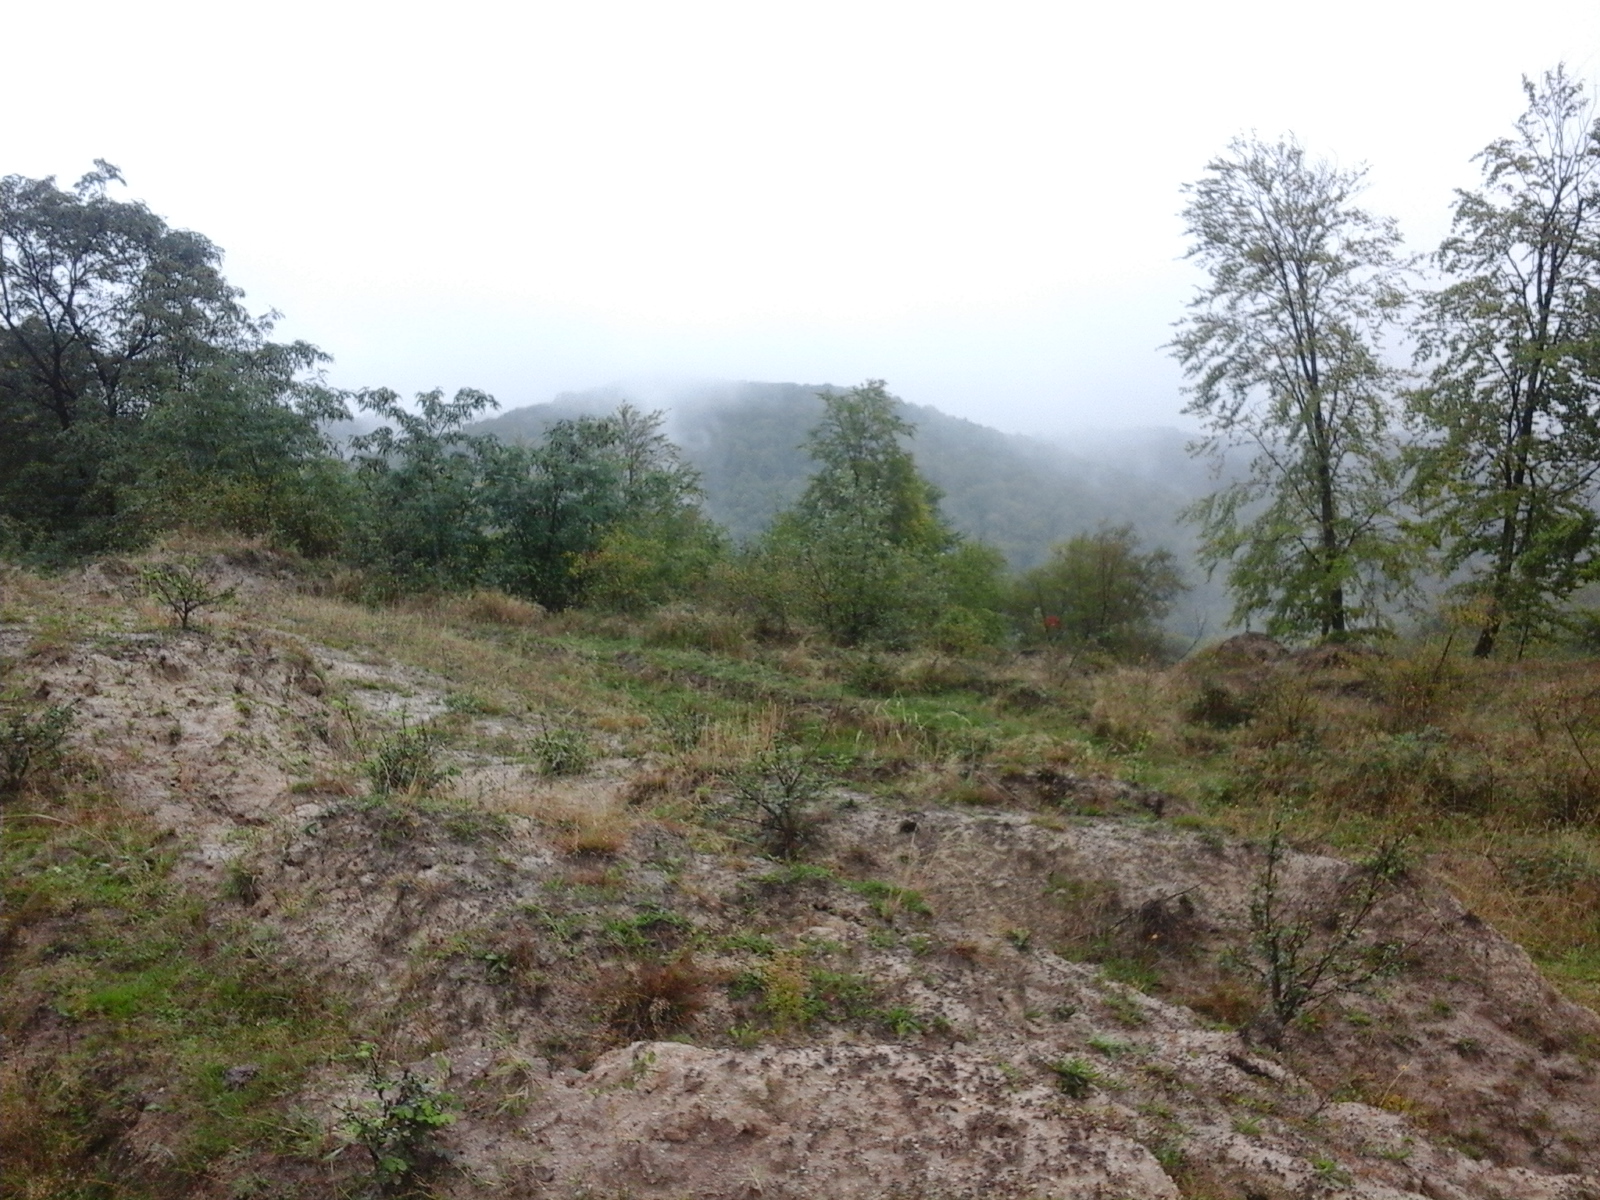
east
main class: Grassland
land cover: Spontaneously vegetated surfaces
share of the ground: > 75 %
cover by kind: herbaceous plants 100 %
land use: Fallow land
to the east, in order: Spontaneously vegetated surfaces; Grassland with sparse tree/shrub cover; Spontaneously vegetated surfaces; Broadleaved woodland
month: September
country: RO
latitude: 44.9839
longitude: 23.7456
